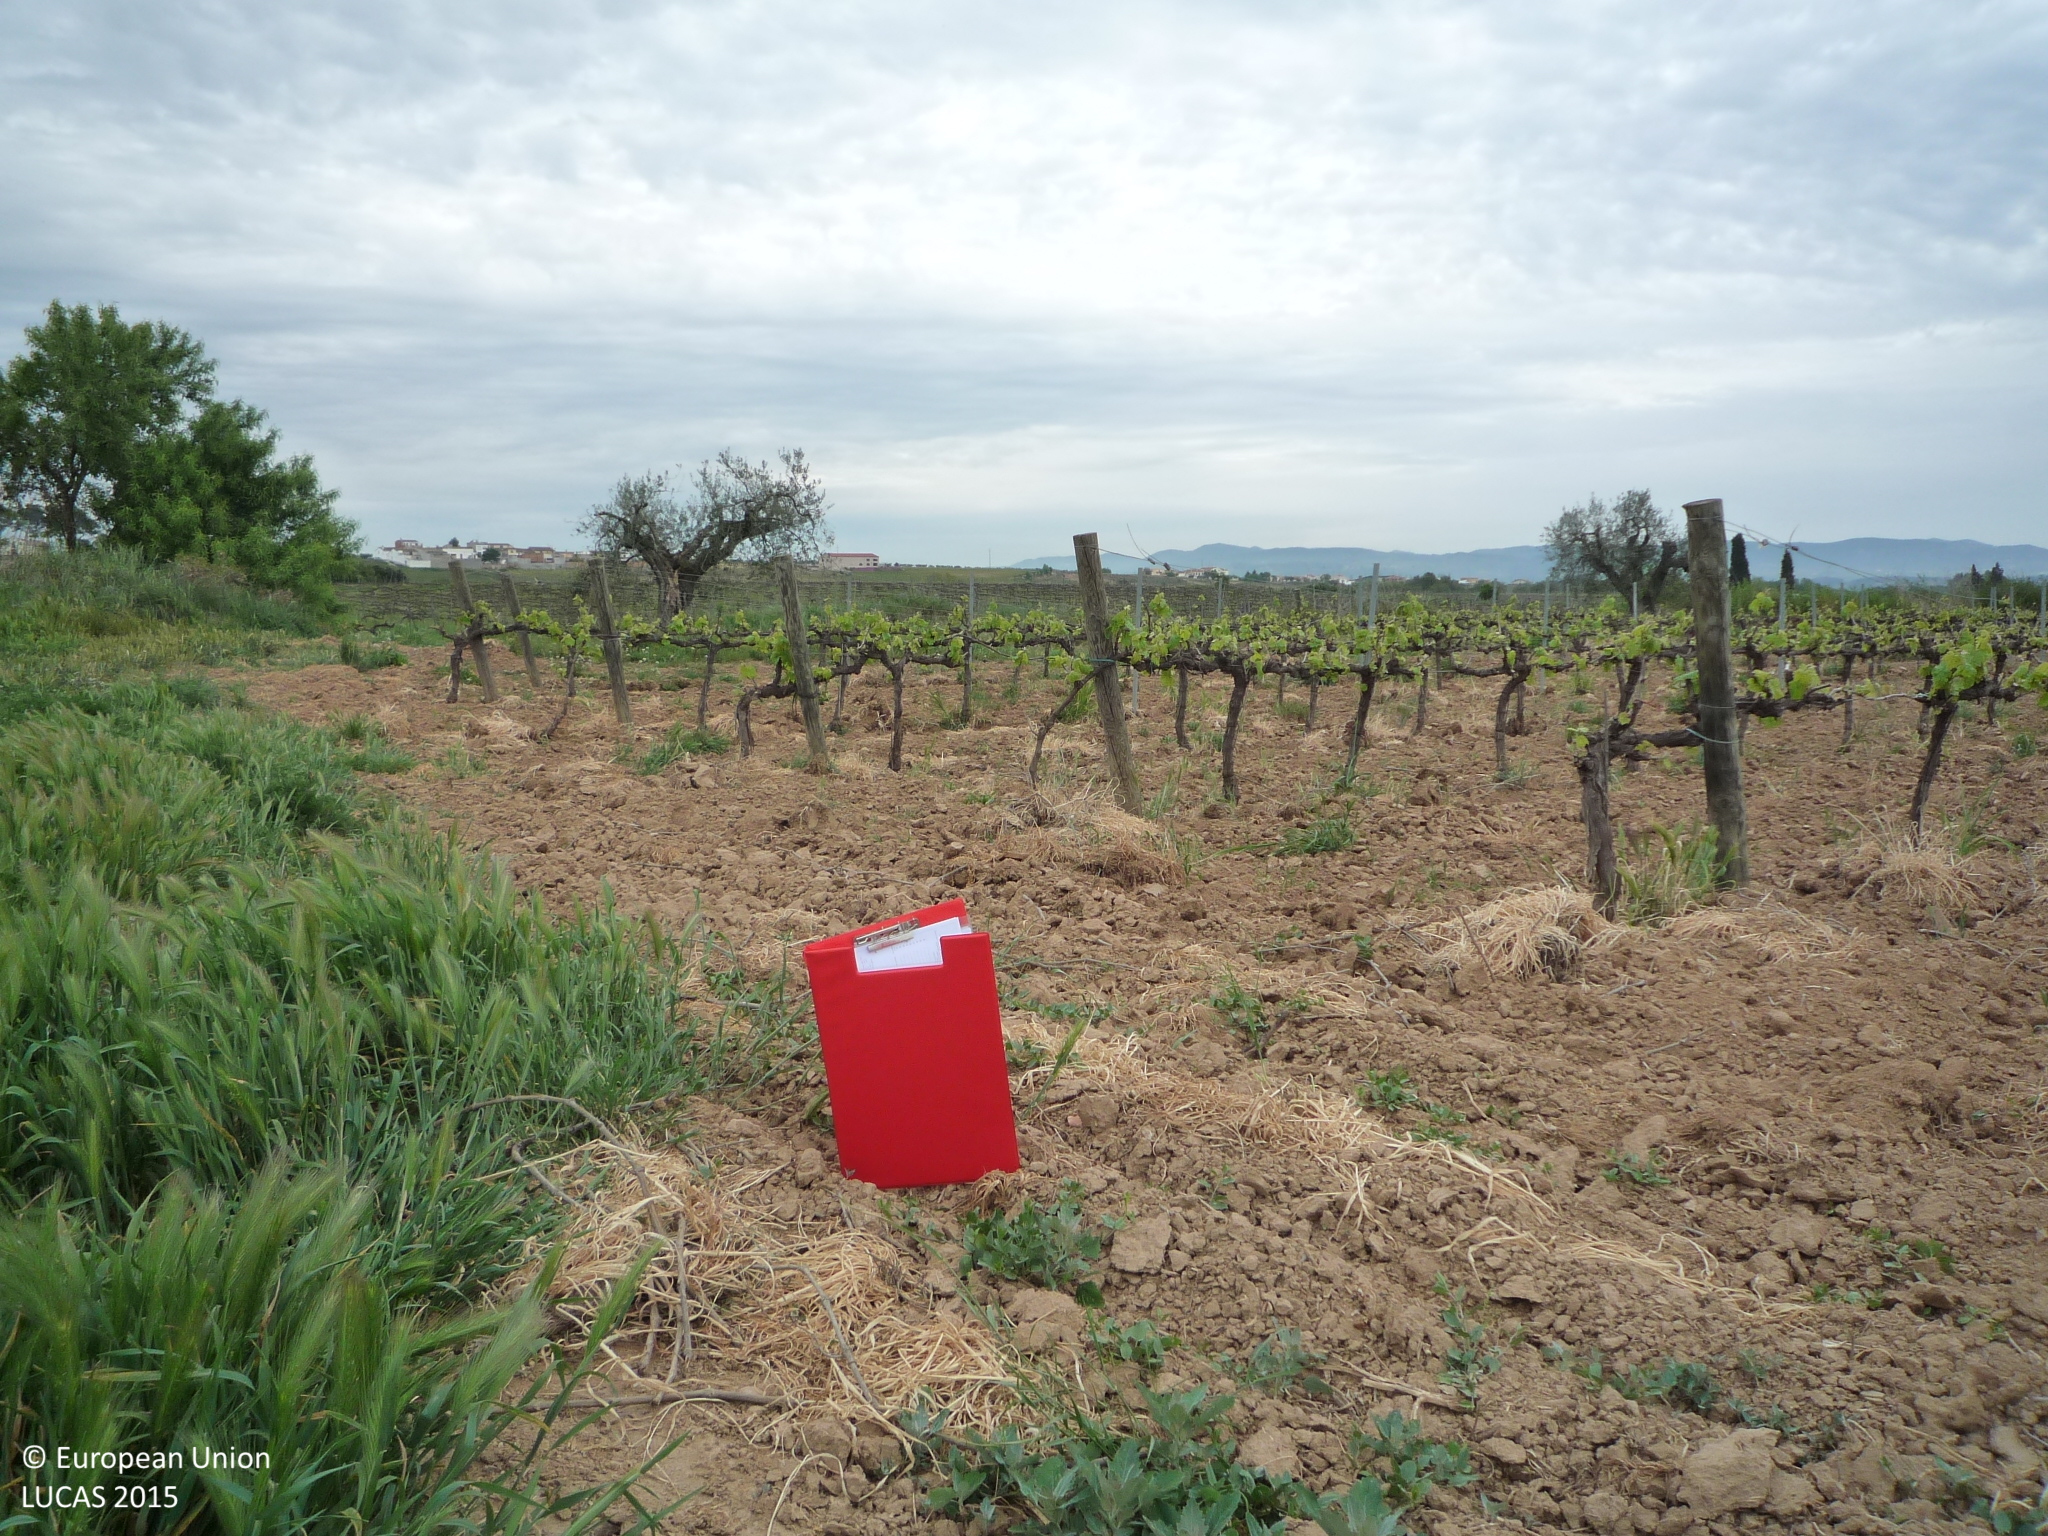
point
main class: Cropland
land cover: Vineyards
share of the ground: > 75 %
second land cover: Other bare soil
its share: > 75 %
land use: Agriculture (excluding fallow land and kitchen gardens)
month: April
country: ES
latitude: 41.4035
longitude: 1.6796
